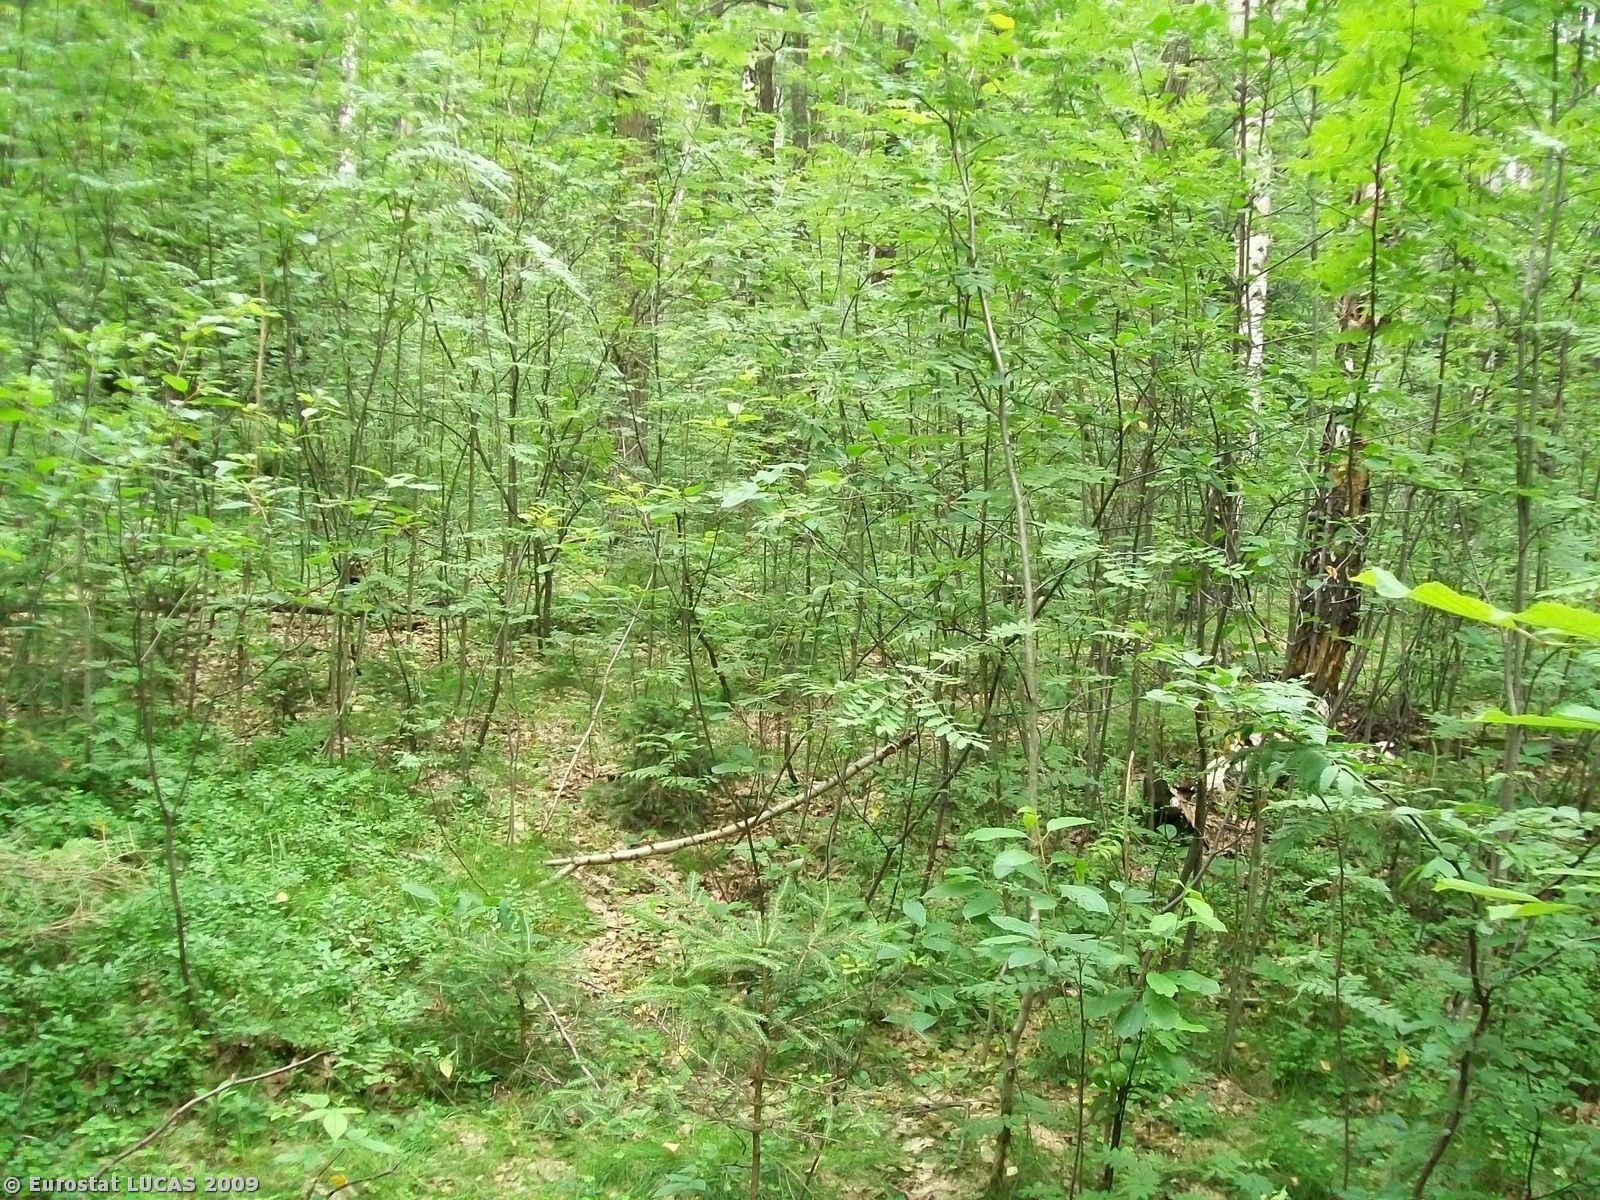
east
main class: Woodland
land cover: Mixed woodland
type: hemiboreal forest and nemoral coniferous forest and mixed broadleaved-coniferous forest
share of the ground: > 75 %
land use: Forestry
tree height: > 5 m
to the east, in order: Mixed woodland; Coniferous woodland
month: July
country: PL
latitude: 51.0228
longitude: 15.1500
